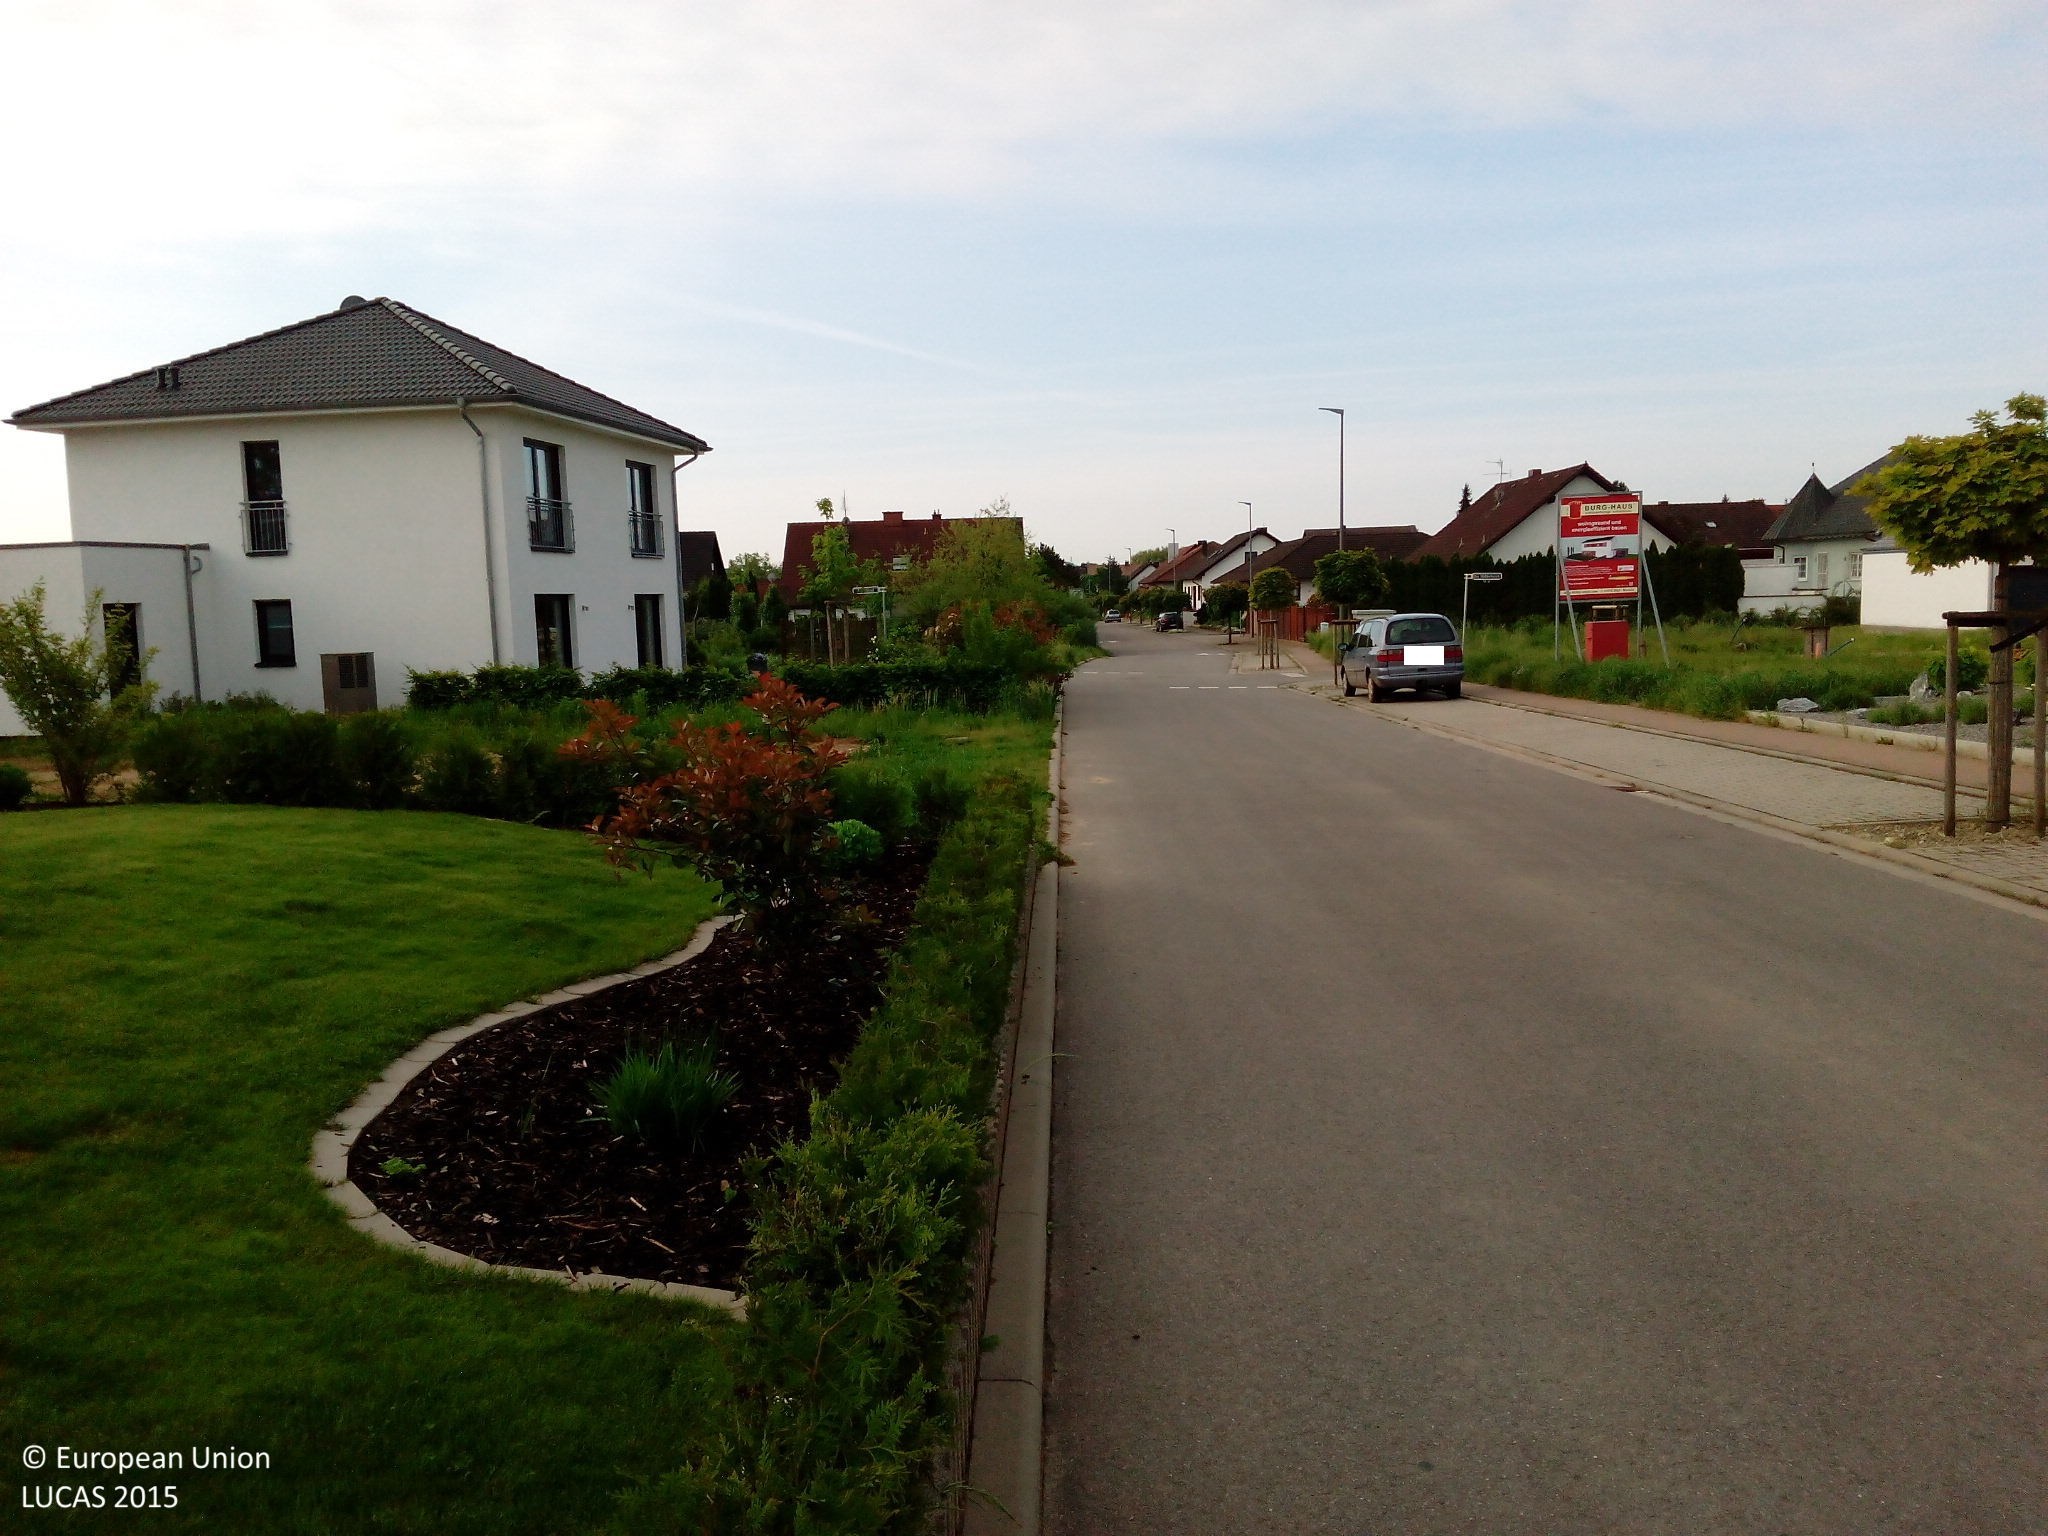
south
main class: Grassland
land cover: Grassland without tree/shrub cover
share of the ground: > 75 %
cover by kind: herbaceous plants 95 %, unconsolidated bare surface 5 %
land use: Residential
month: May
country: DE
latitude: 49.0719
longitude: 8.1526
